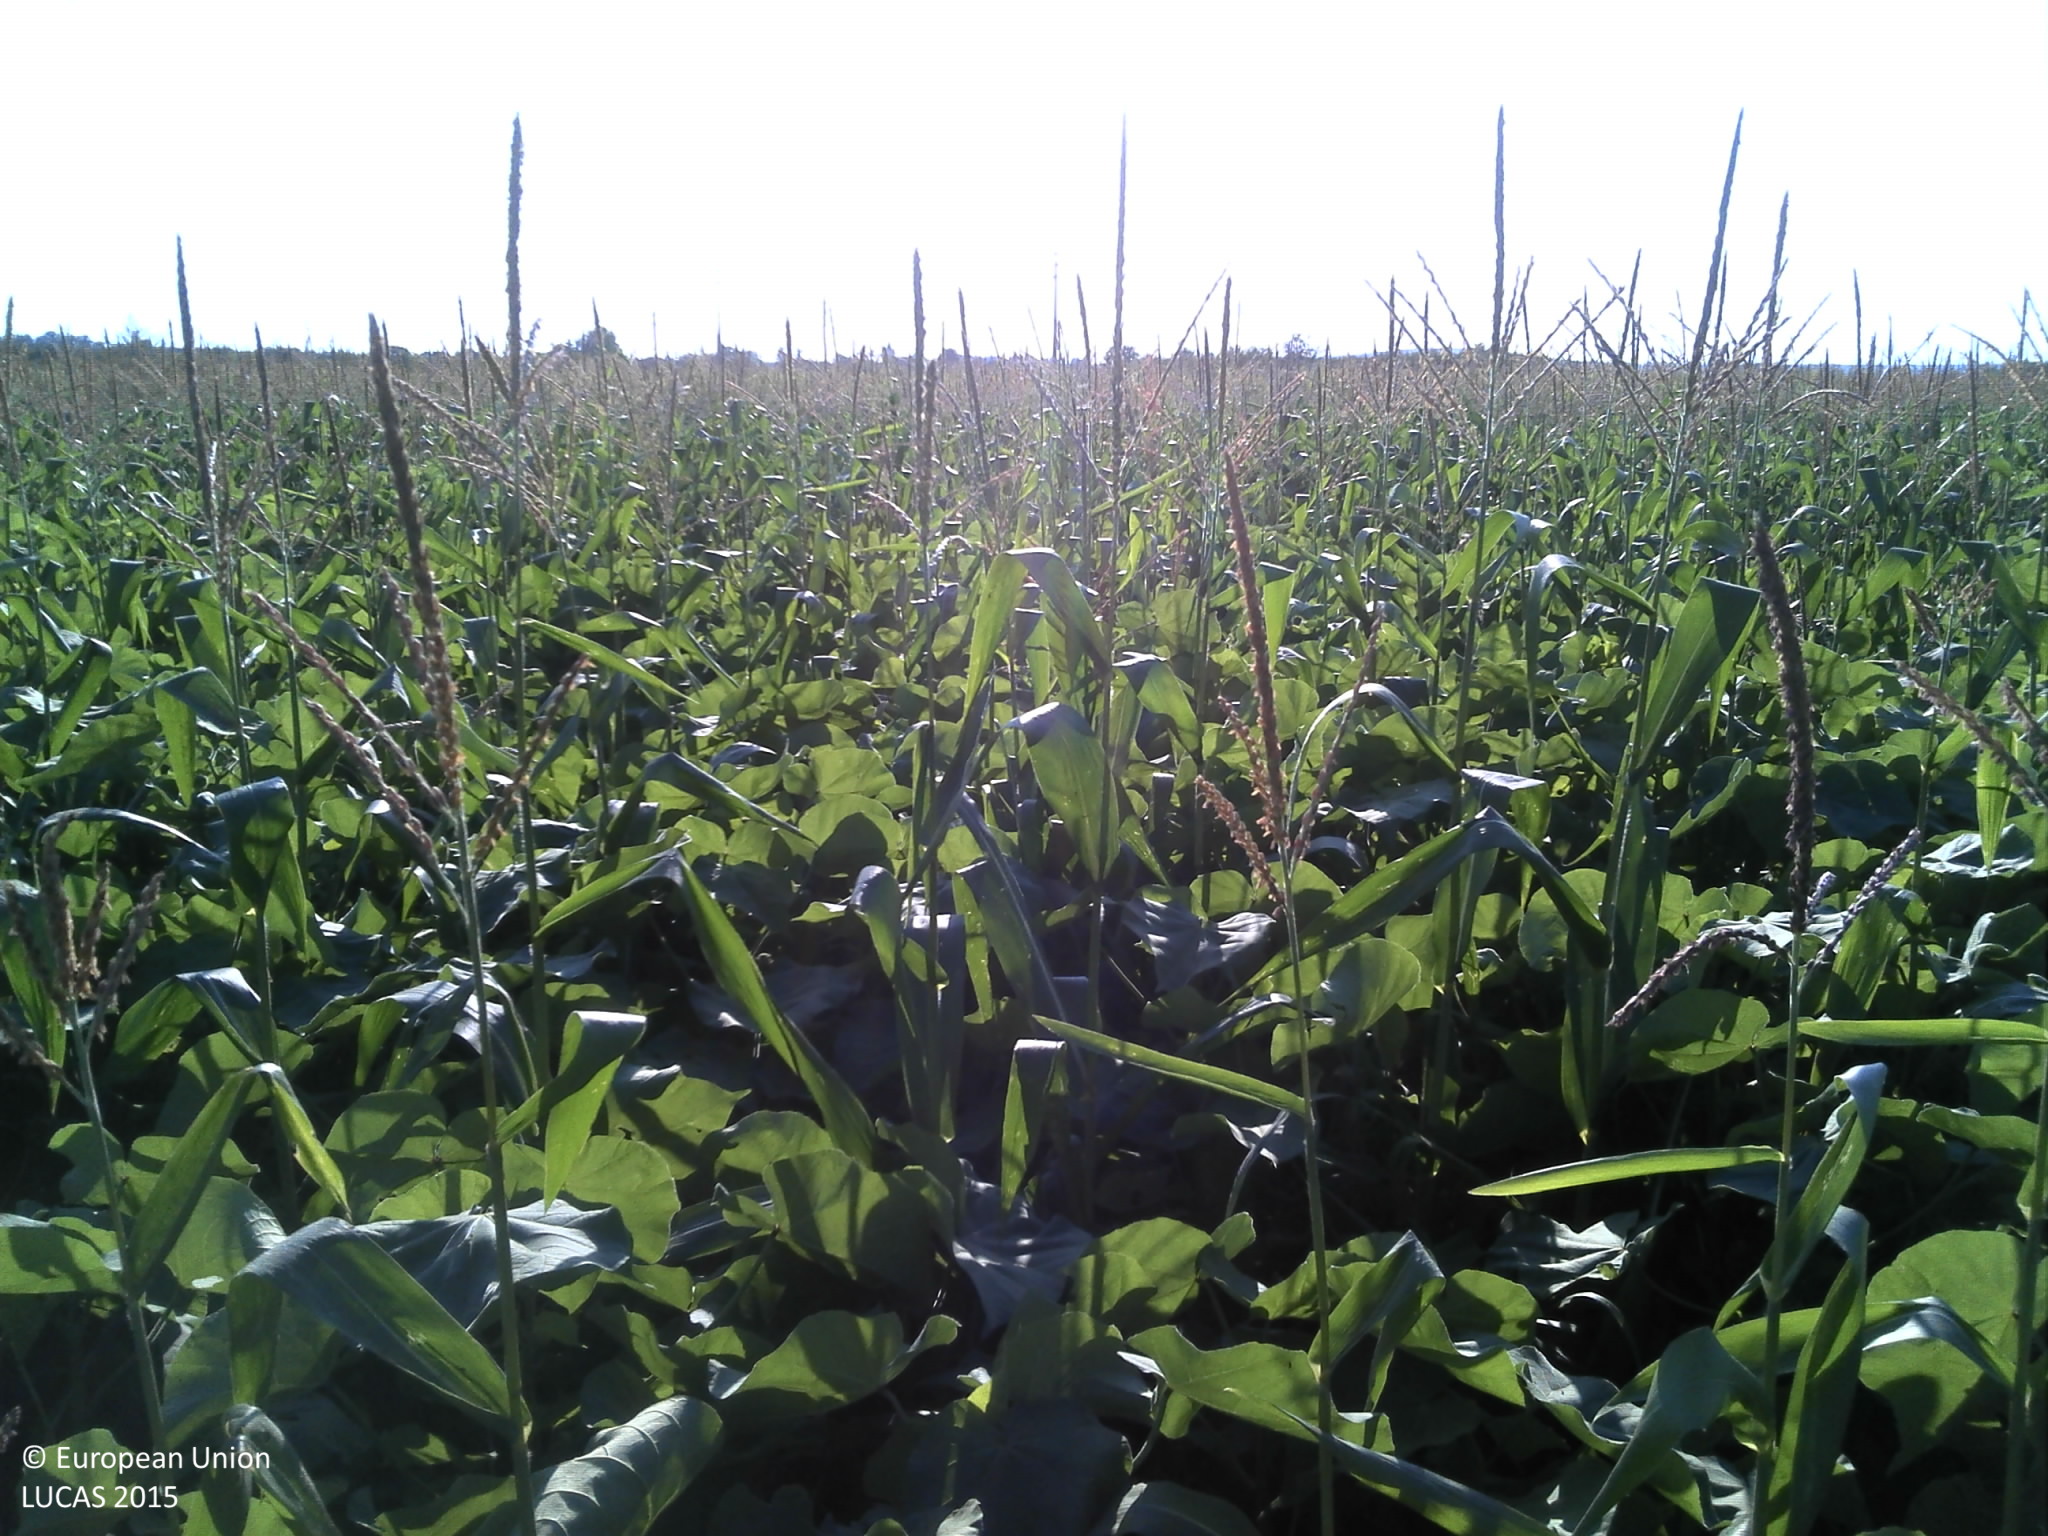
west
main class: Cropland
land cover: Maize
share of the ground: 25 - 50 %
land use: Agriculture (excluding fallow land and kitchen gardens)
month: August
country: HR
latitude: 45.1880
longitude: 18.1616
